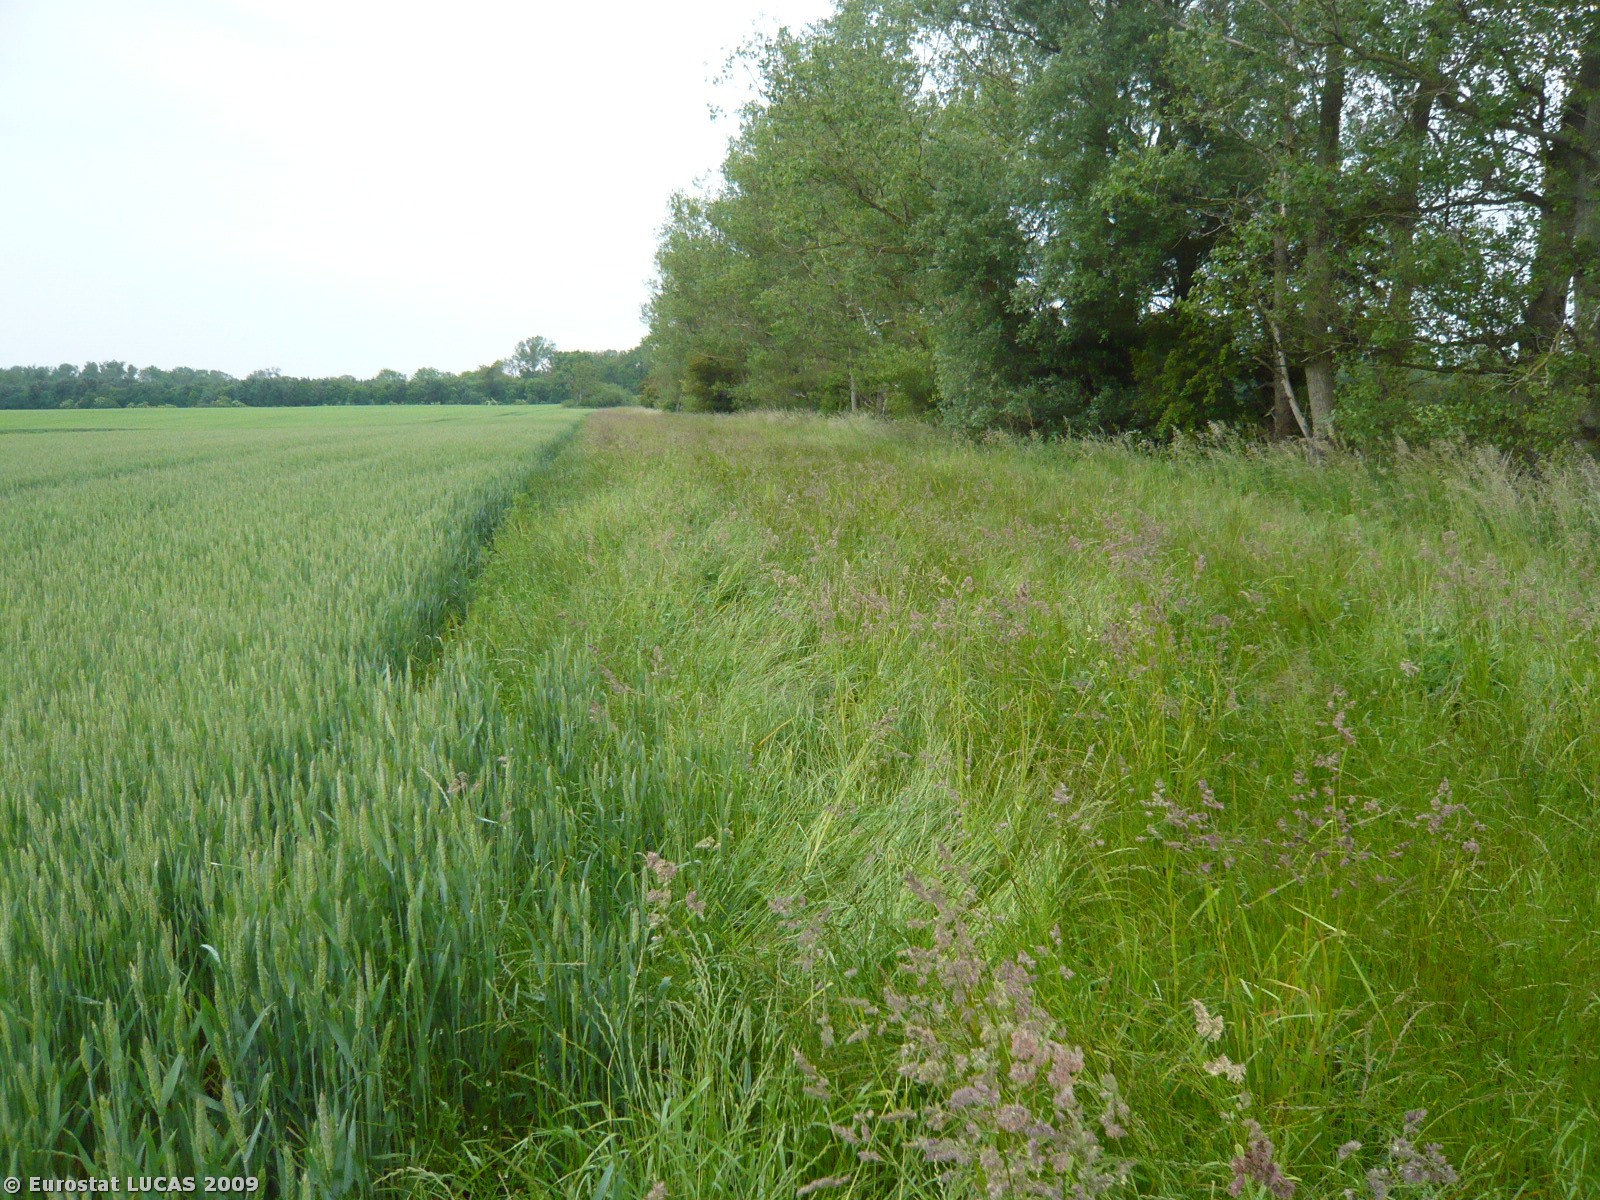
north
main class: Grassland
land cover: Grassland without tree/shrub cover
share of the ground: > 75 %
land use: Agriculture (excluding fallow land and kitchen gardens)
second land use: Road transport
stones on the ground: < 10 %
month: June
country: DK
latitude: 54.7555
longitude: 11.7547
